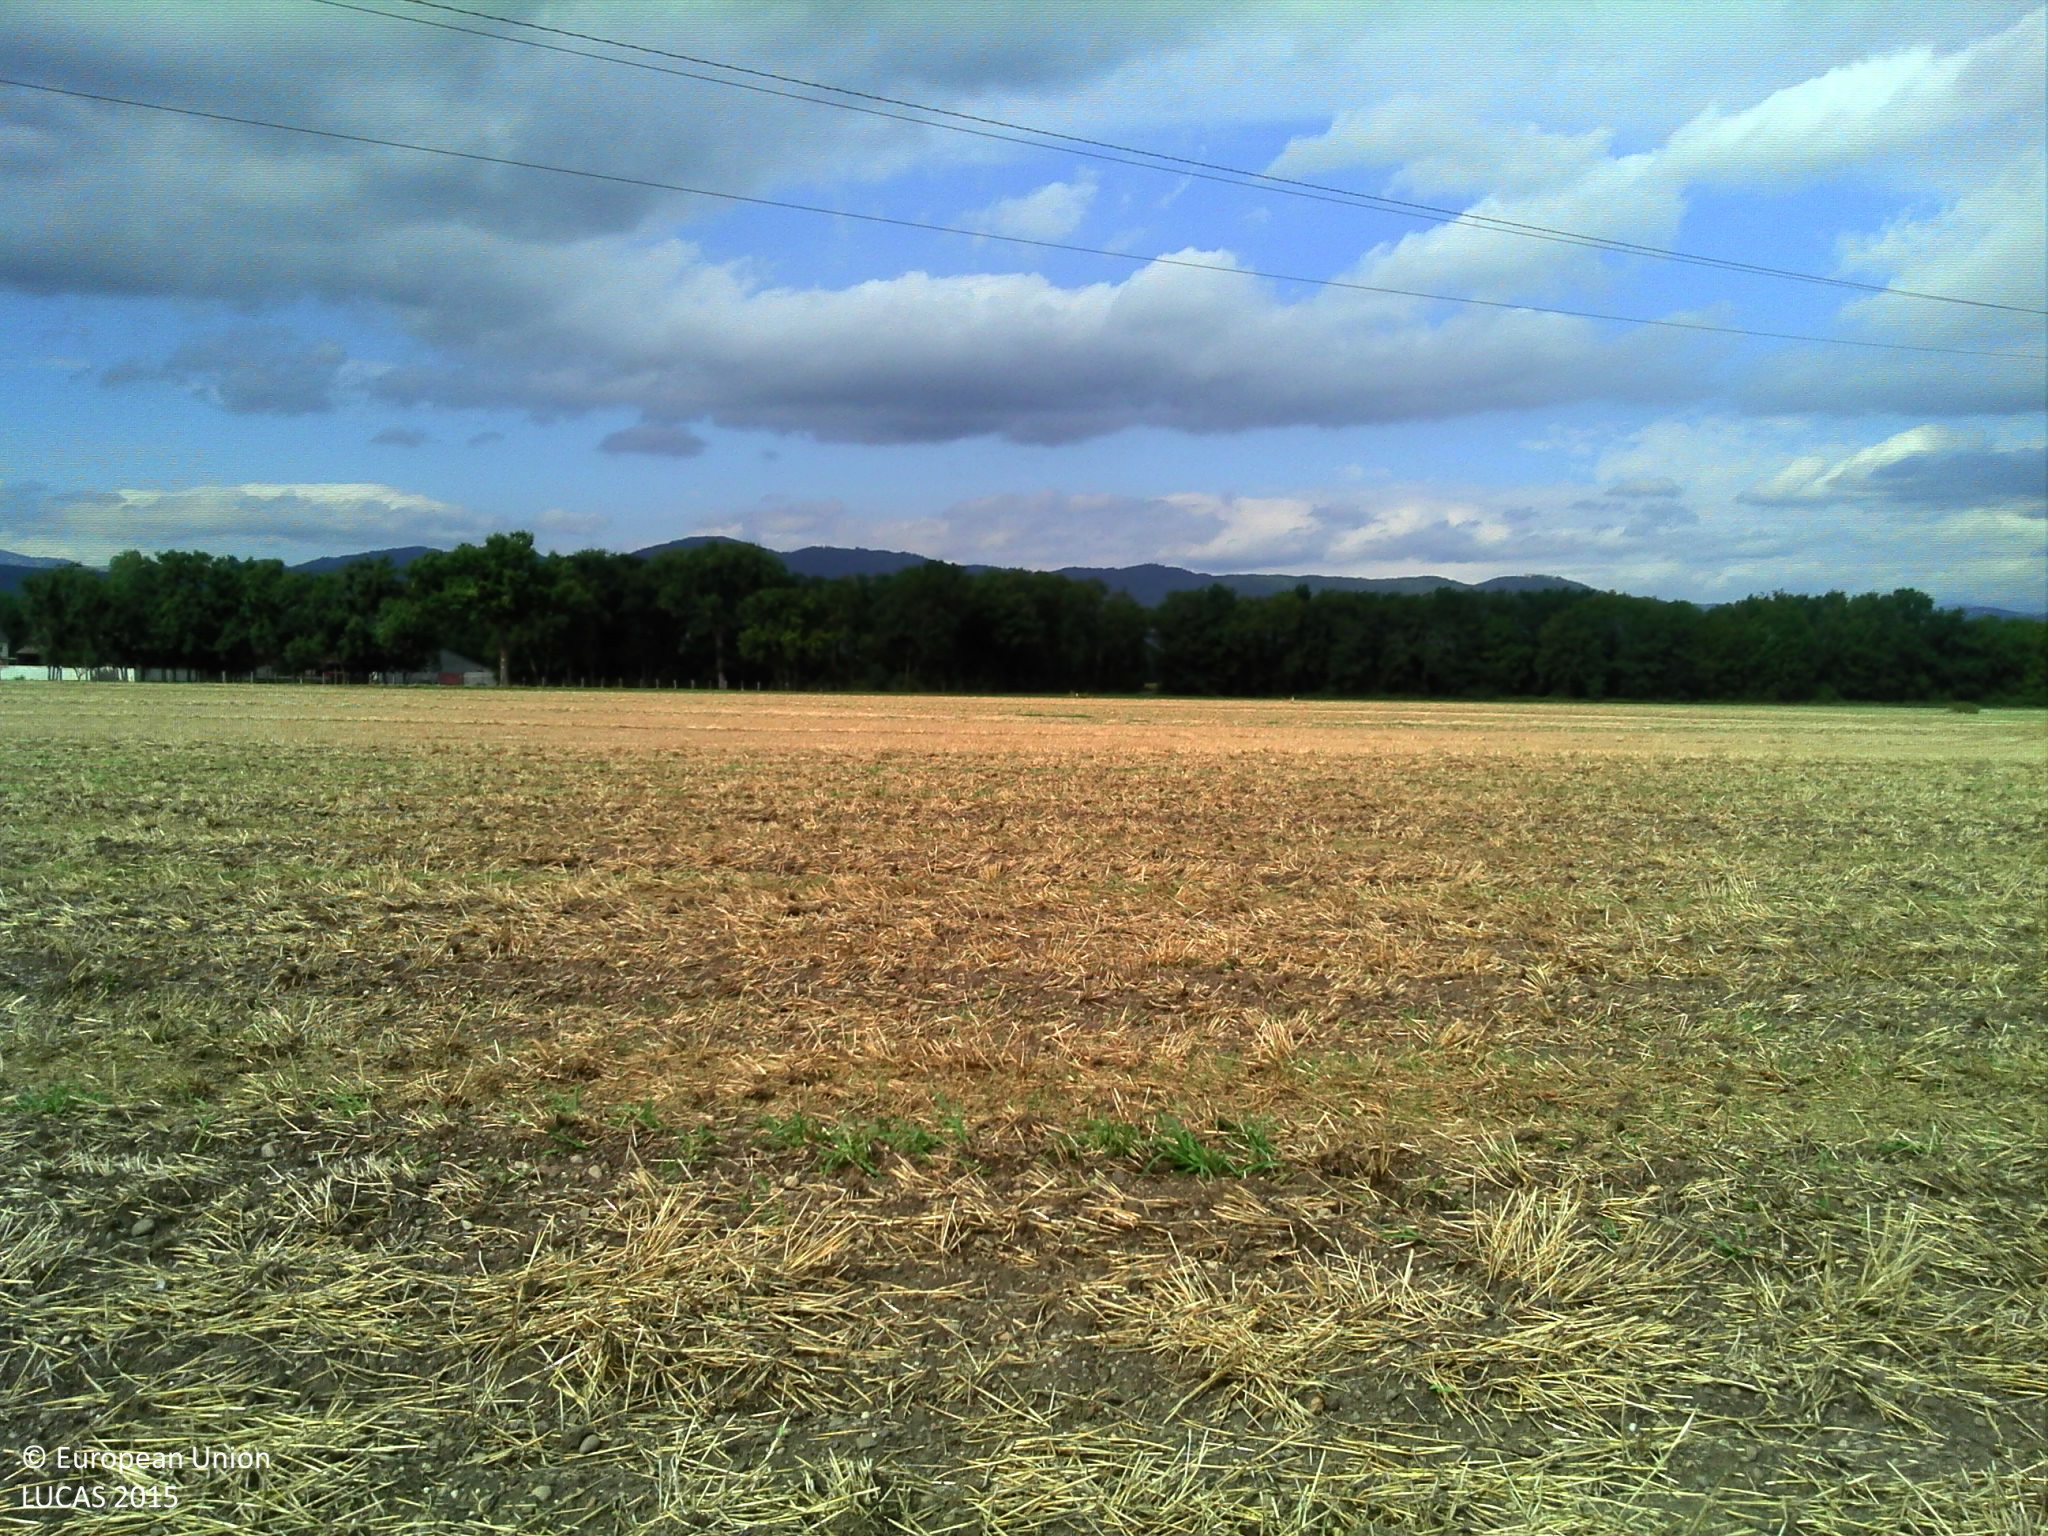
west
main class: Cropland
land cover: Common wheat
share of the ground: 10 - 25 %
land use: Agriculture (excluding fallow land and kitchen gardens)
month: August
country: FR
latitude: 48.0299
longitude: 7.3594
